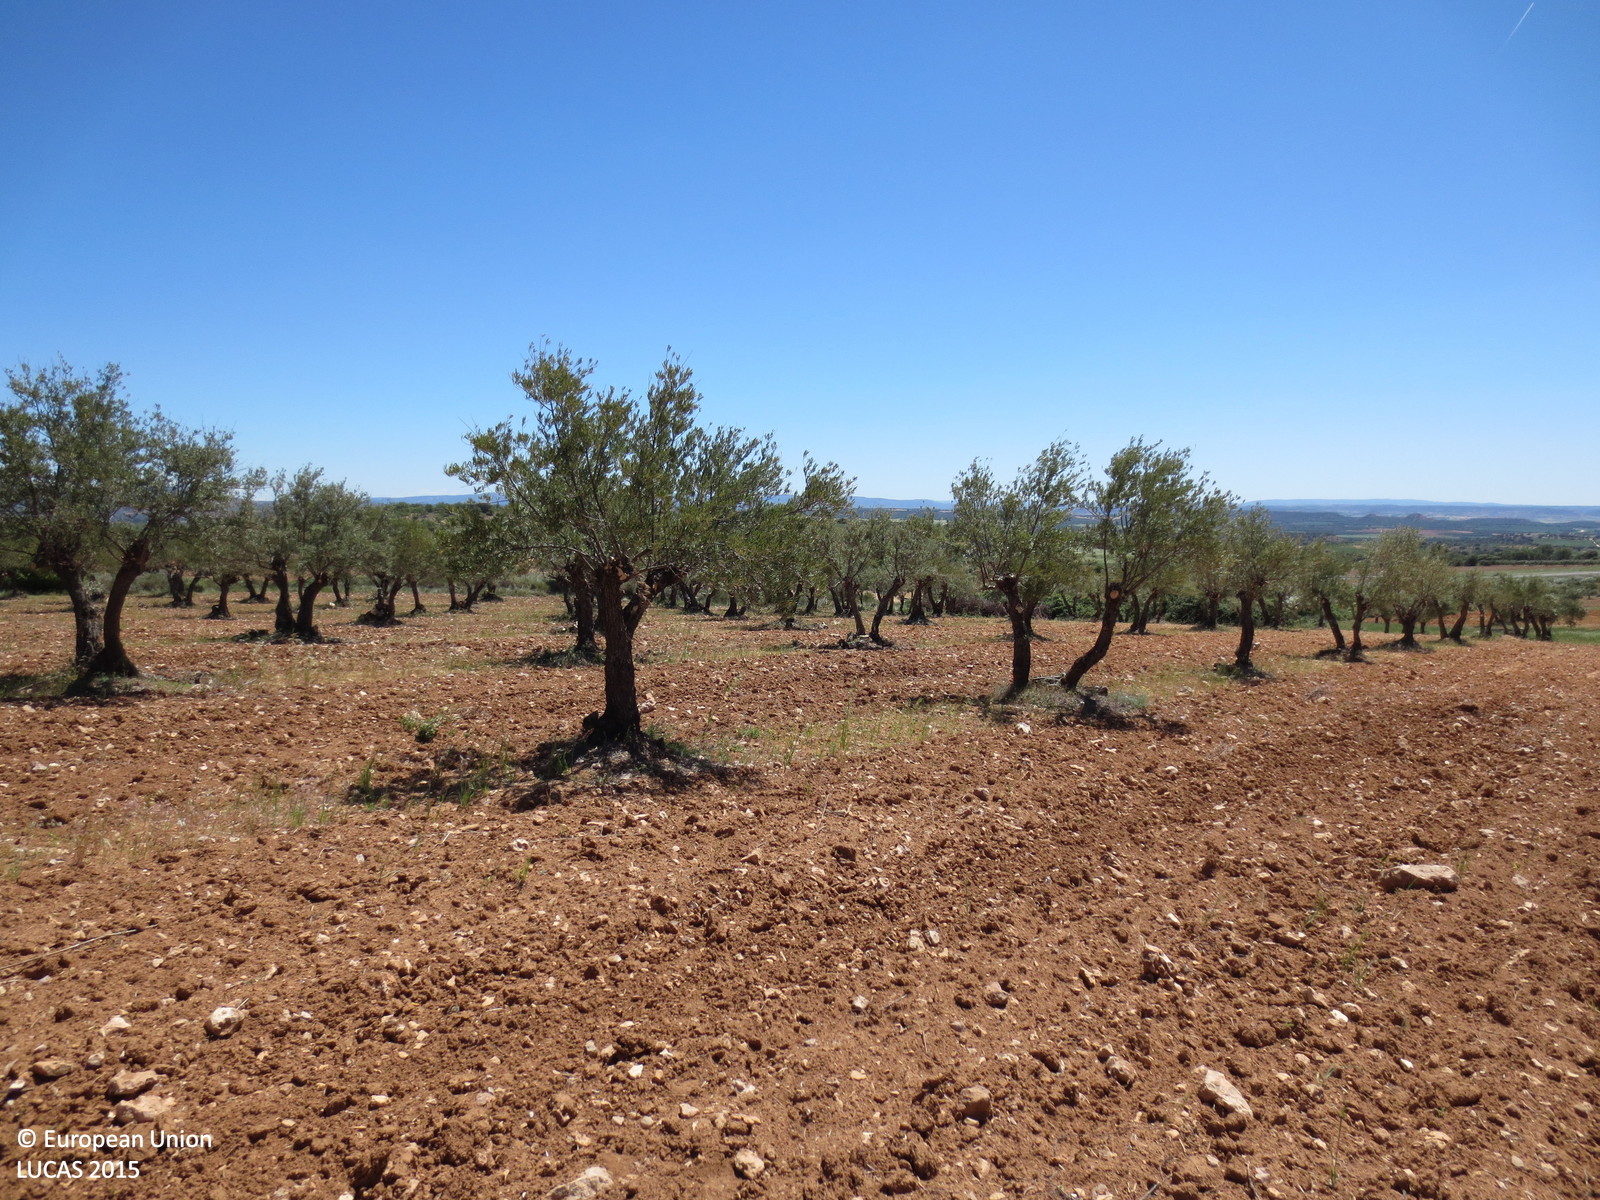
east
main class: Cropland
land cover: Olive groves
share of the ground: 50 - 75 %
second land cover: Other bare soil
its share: > 75 %
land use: Agriculture (excluding fallow land and kitchen gardens)
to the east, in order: Olive groves; Other bare soil; Grass margins; Rivers and streams; Grass margins; Olive groves; Tracks; Olive groves
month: May
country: ES
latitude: 40.4949
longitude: -2.5910
